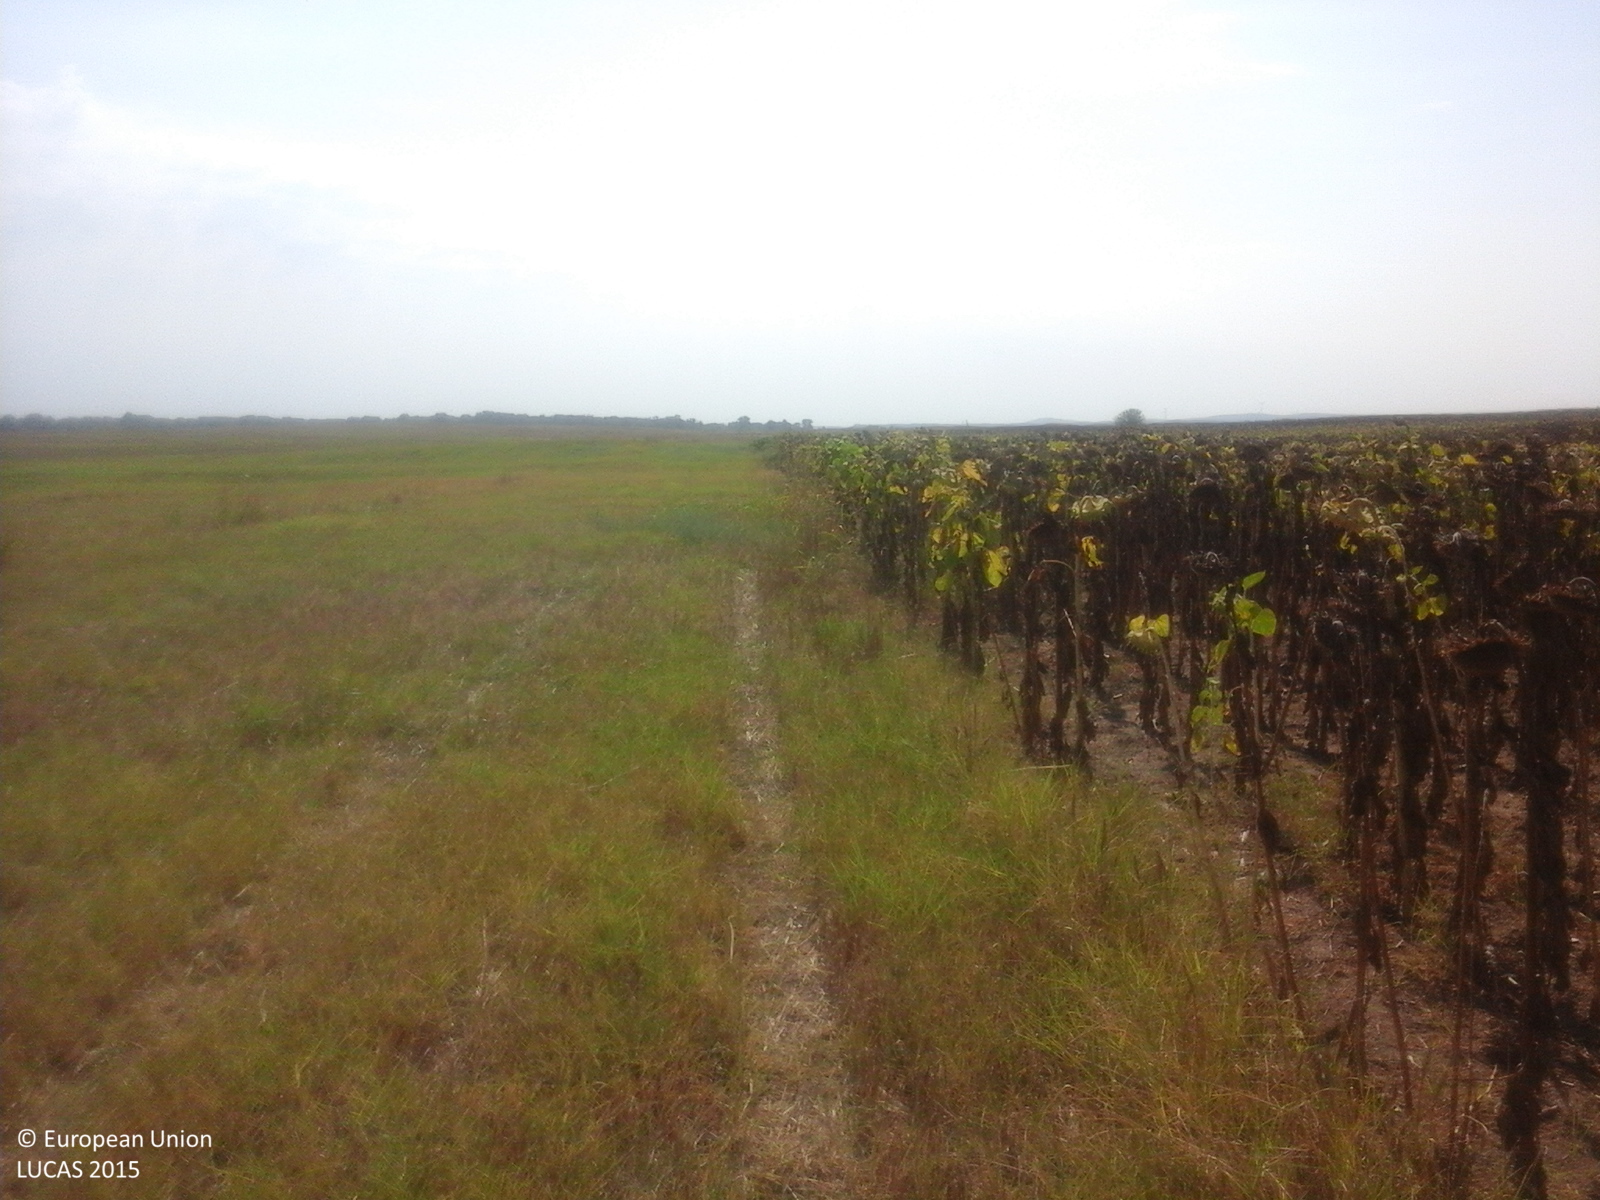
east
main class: Cropland
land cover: Sunflower
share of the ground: > 75 %
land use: Agriculture (excluding fallow land and kitchen gardens)
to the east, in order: Sunflower; Spontaneously vegetated surfaces
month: August
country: RO
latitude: 43.8416
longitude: 23.5434
